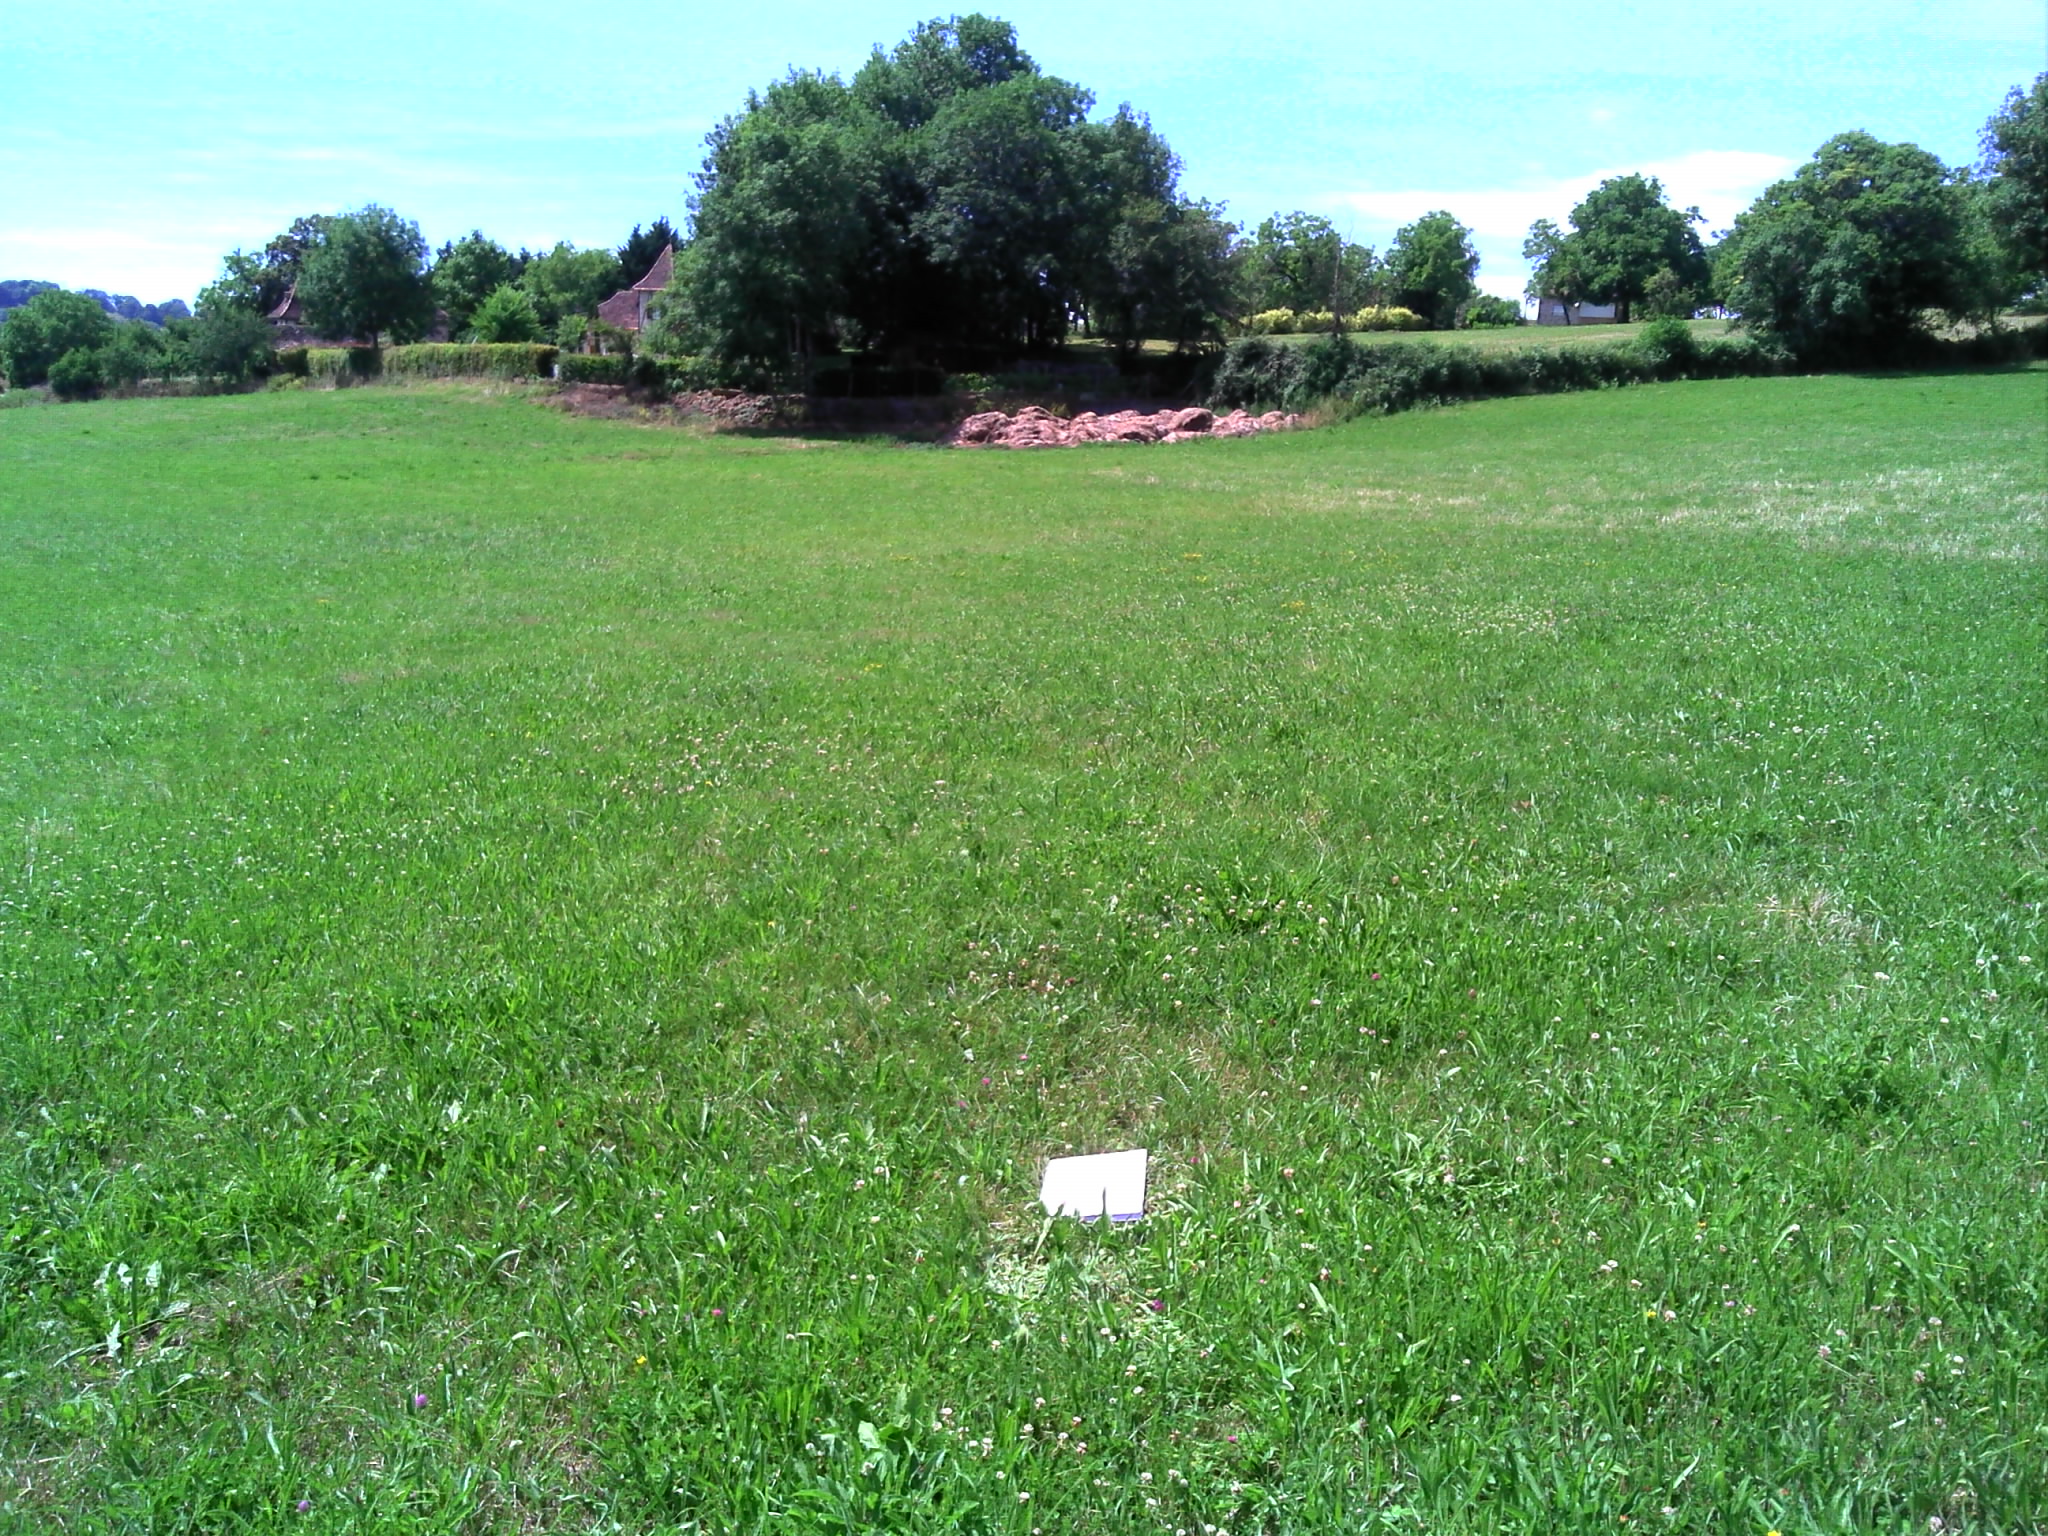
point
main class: Grassland
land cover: Grassland without tree/shrub cover
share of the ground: > 75 %
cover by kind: herbaceous plants 100 %
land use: Agriculture (excluding fallow land and kitchen gardens)
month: June
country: FR
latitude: 44.8201
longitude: 1.7652
